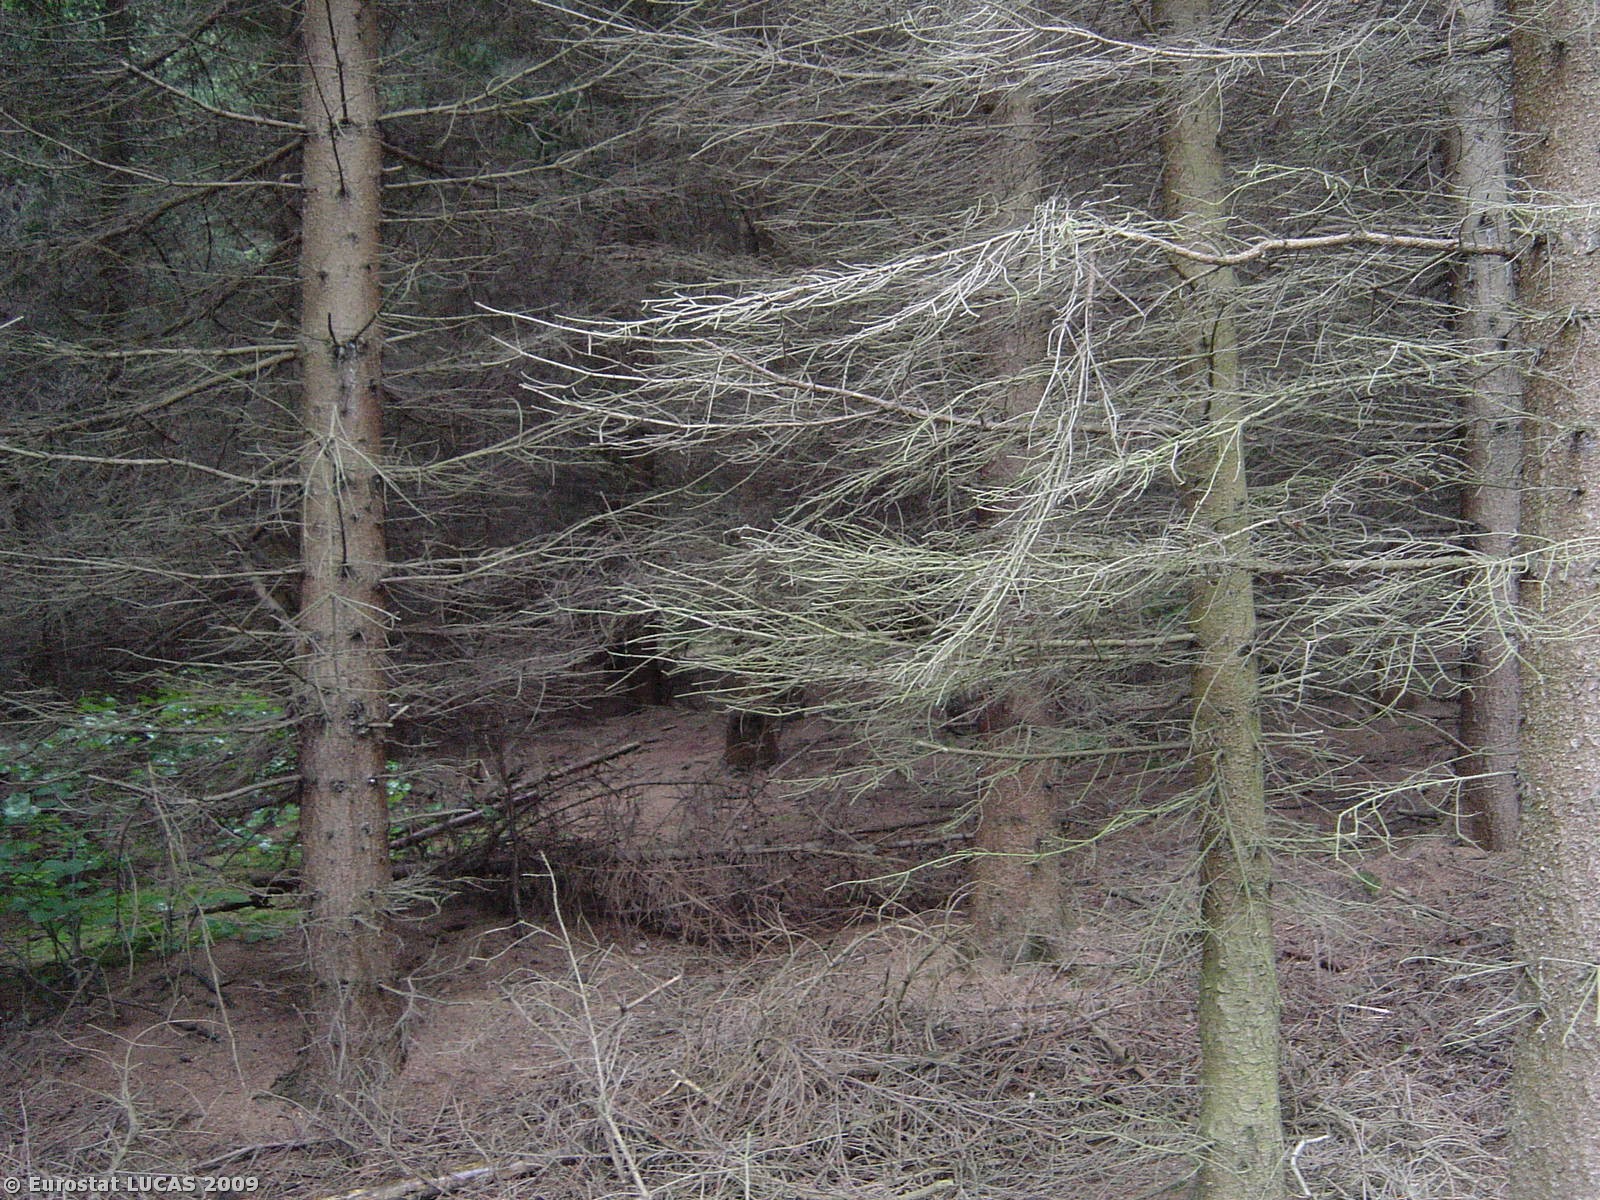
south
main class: Woodland
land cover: Coniferous woodland
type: hemiboreal forest and nemoral coniferous forest and mixed broadleaved-coniferous forest
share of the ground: > 75 %
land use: Forestry
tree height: > 5 m
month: June
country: CZ
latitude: 49.2382
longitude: 17.1381
